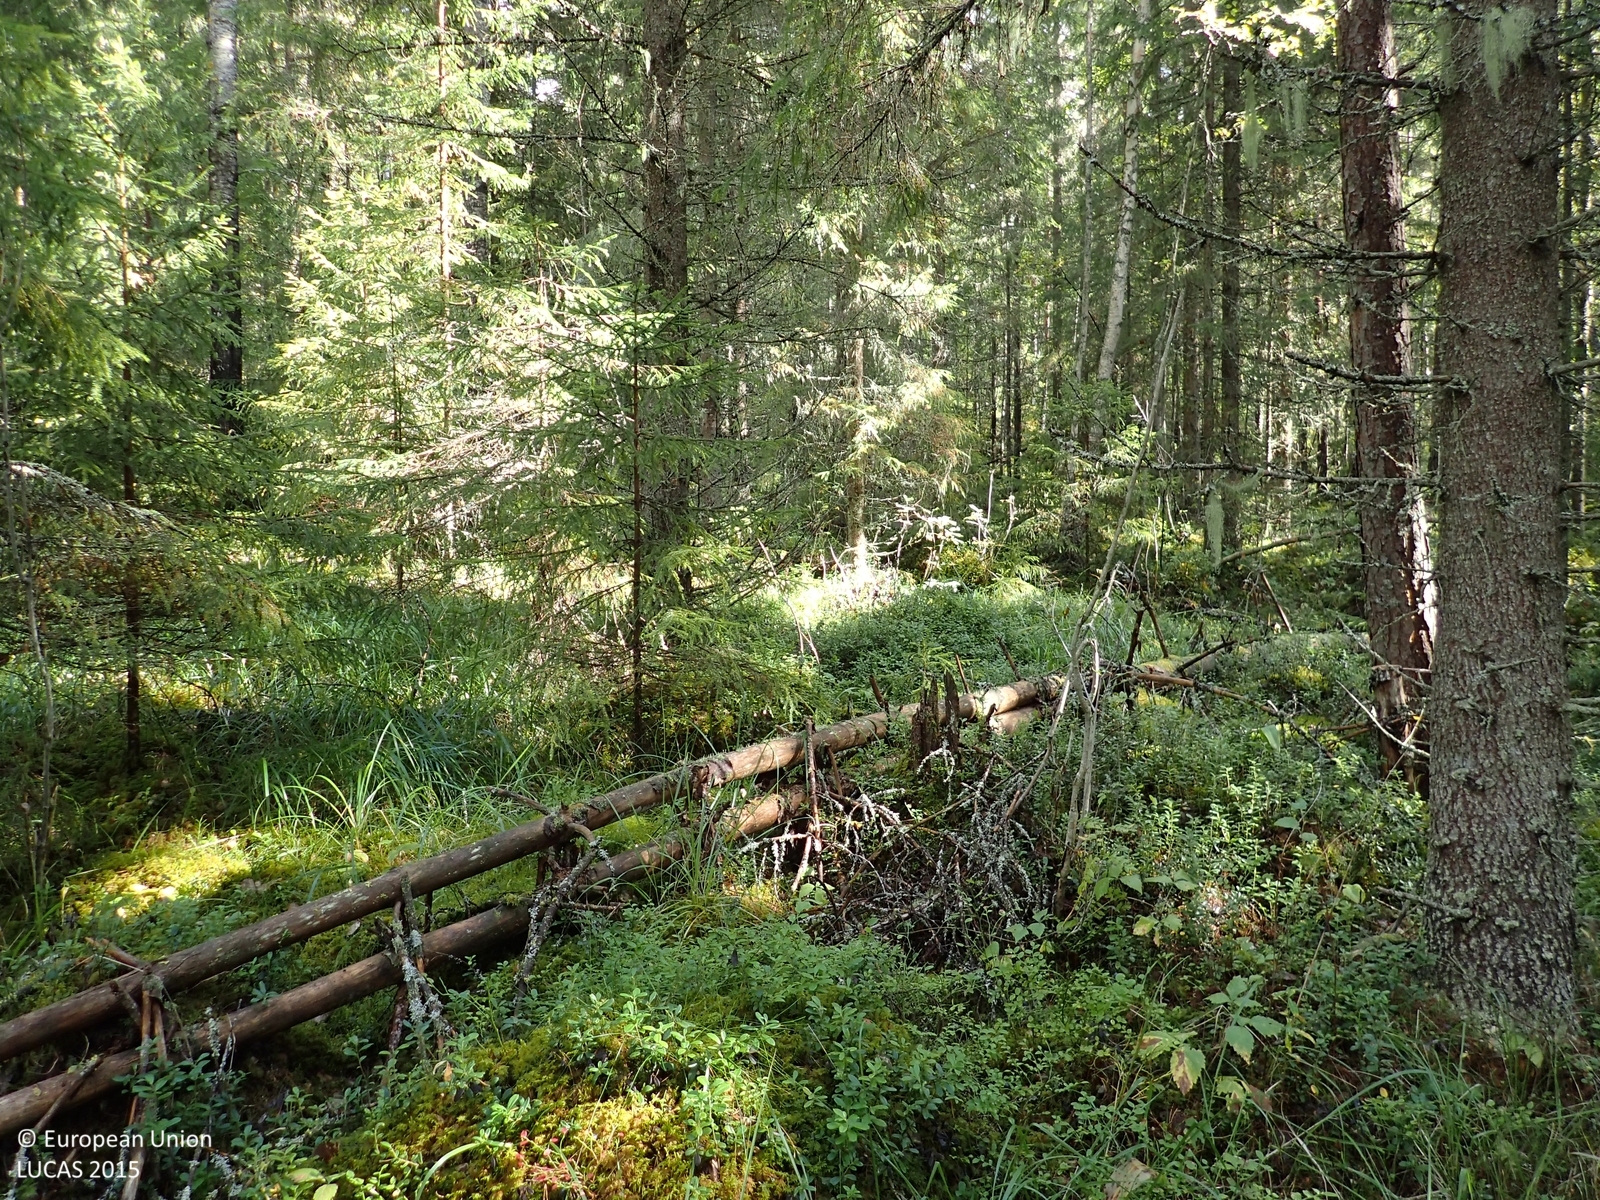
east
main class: Woodland
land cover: Spruce dominated mixed woodland
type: boreal forest
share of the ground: > 75 %
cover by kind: coniferous forest trees 55 %, broadleaved forest trees 20 %, shrubs 10 %, herbaceous plants 10 %, lichens and mosses 5 %
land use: Forestry
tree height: > 5 m
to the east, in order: Spruce dominated mixed woodland; Other mixed woodland; Other coniferous woodland; Pine dominated coniferous woodland
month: September
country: FI
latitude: 63.1890
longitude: 25.8316
